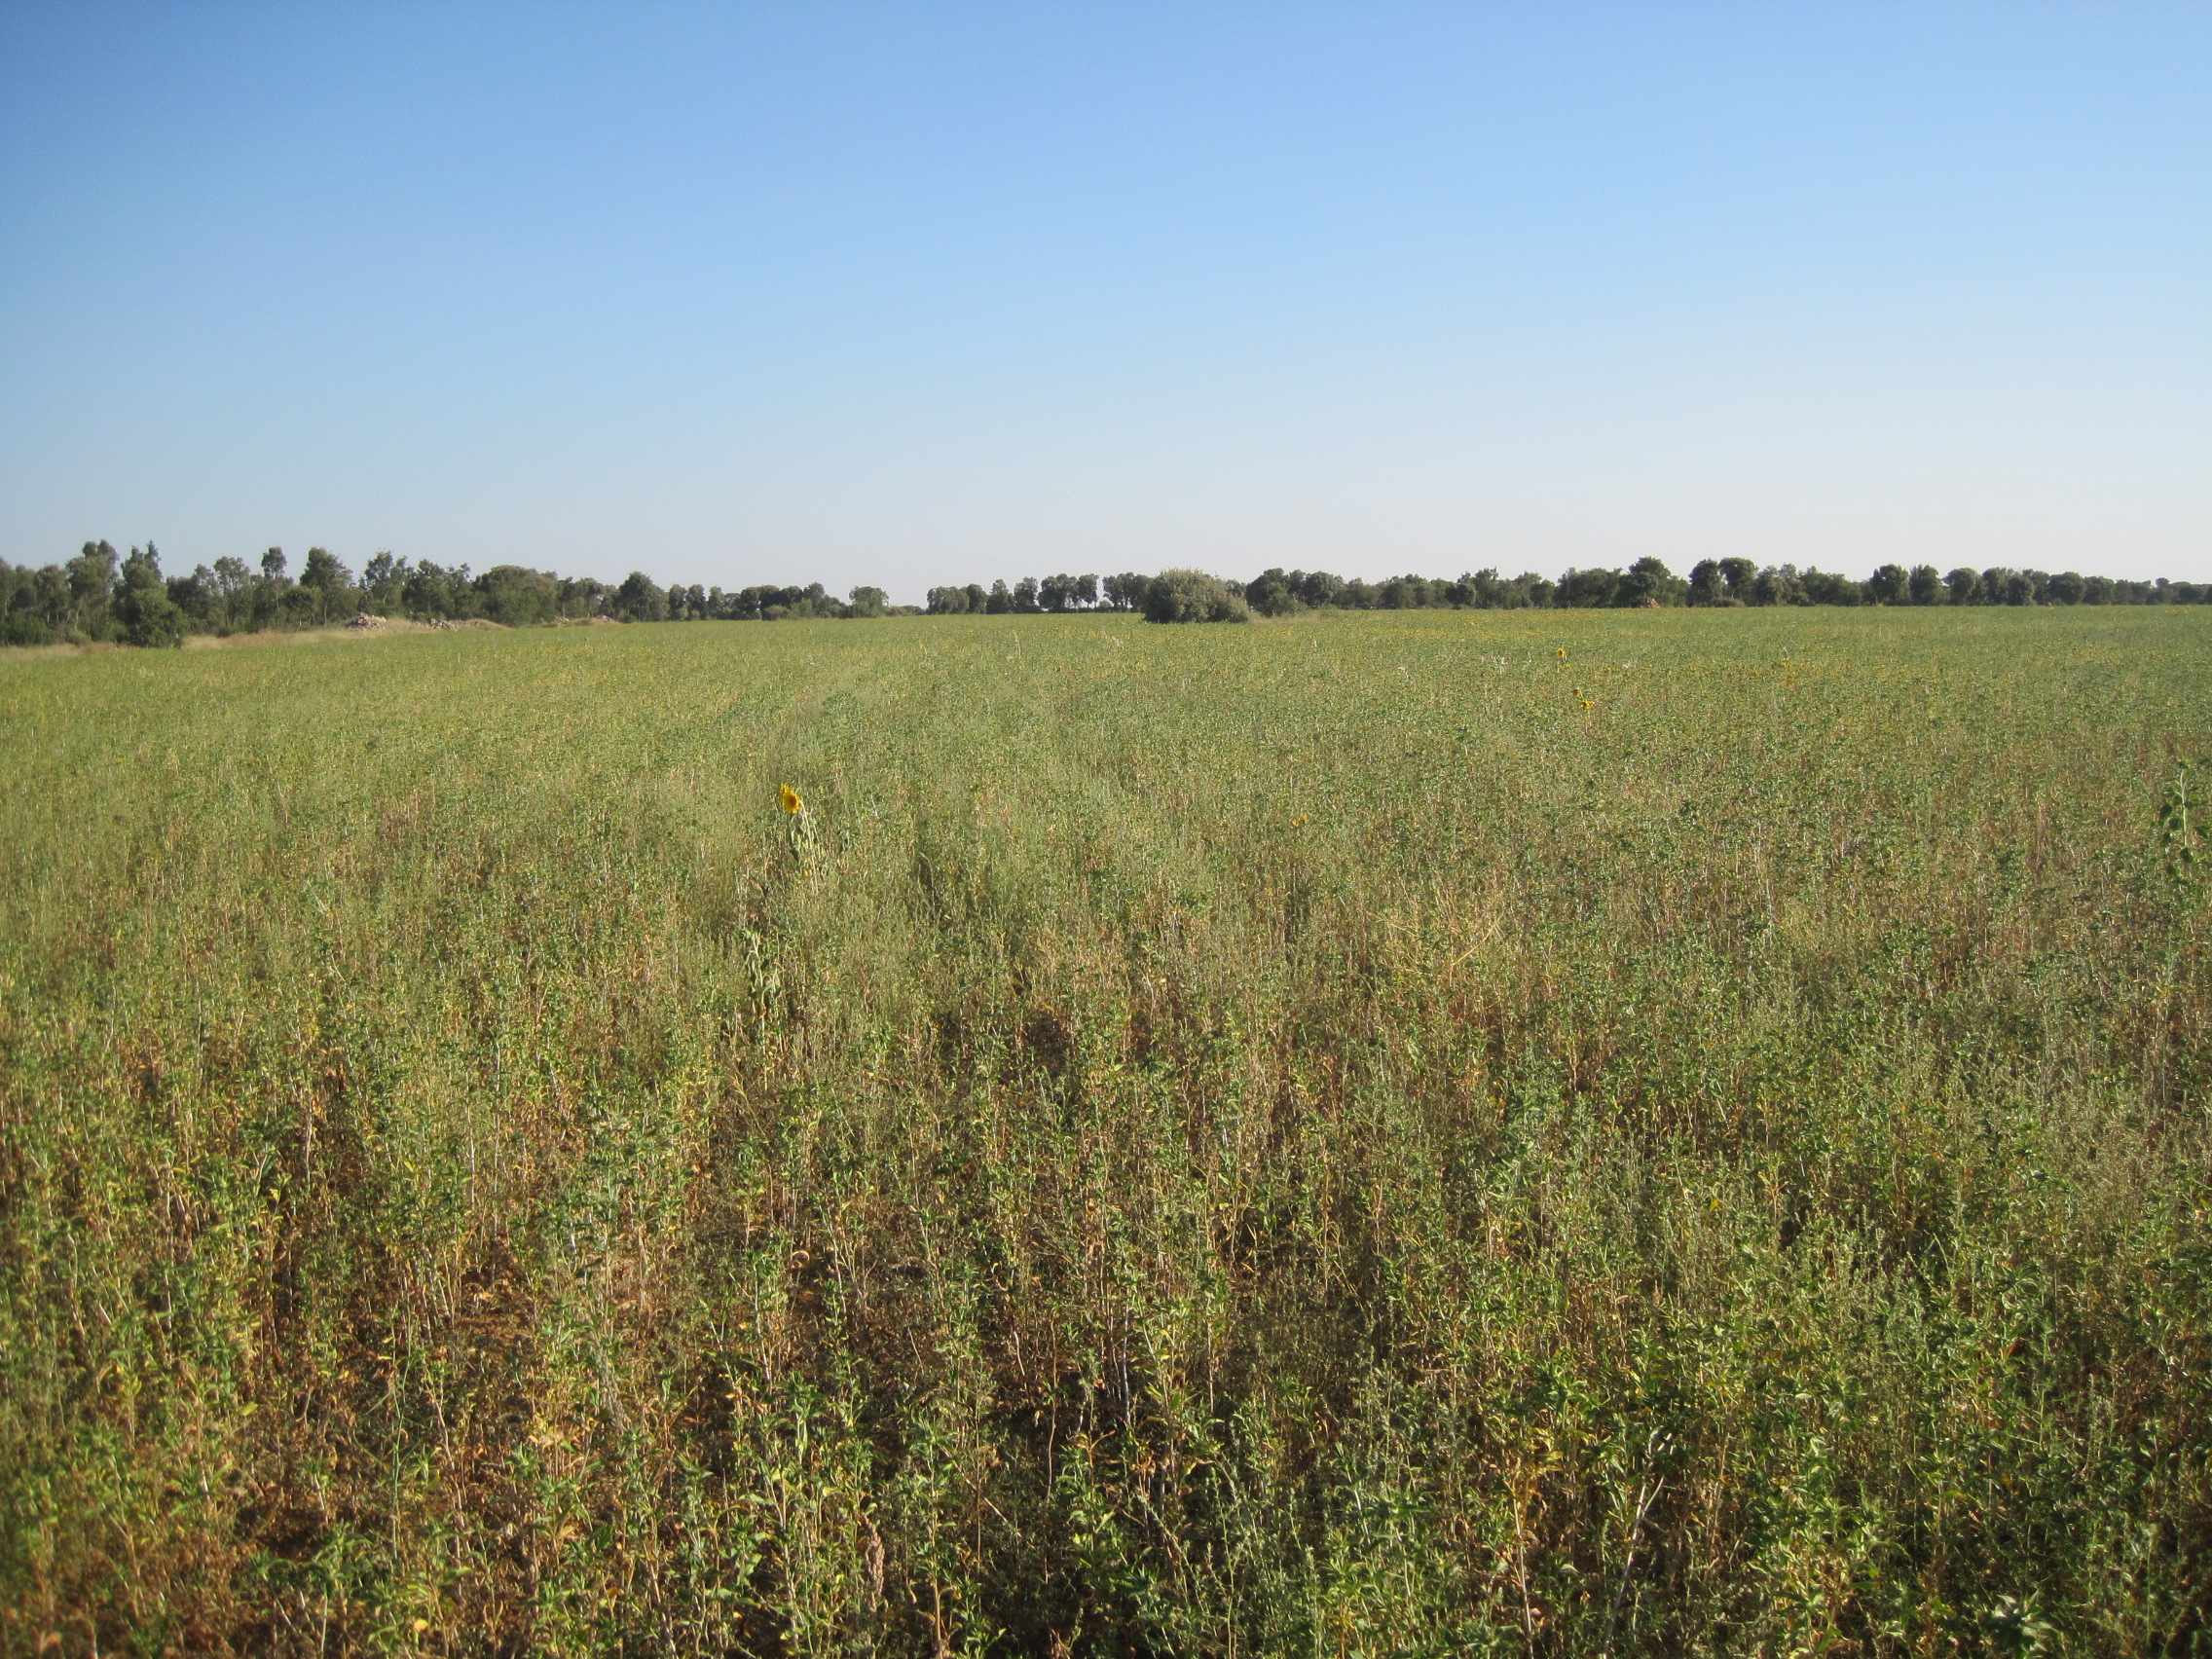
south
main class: Cropland
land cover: Other non-permanent industrial crops
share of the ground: > 75 %
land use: Agriculture (excluding fallow land and kitchen gardens)
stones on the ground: 10 - 25 %
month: July
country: ES
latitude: 41.8242
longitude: -4.7481
